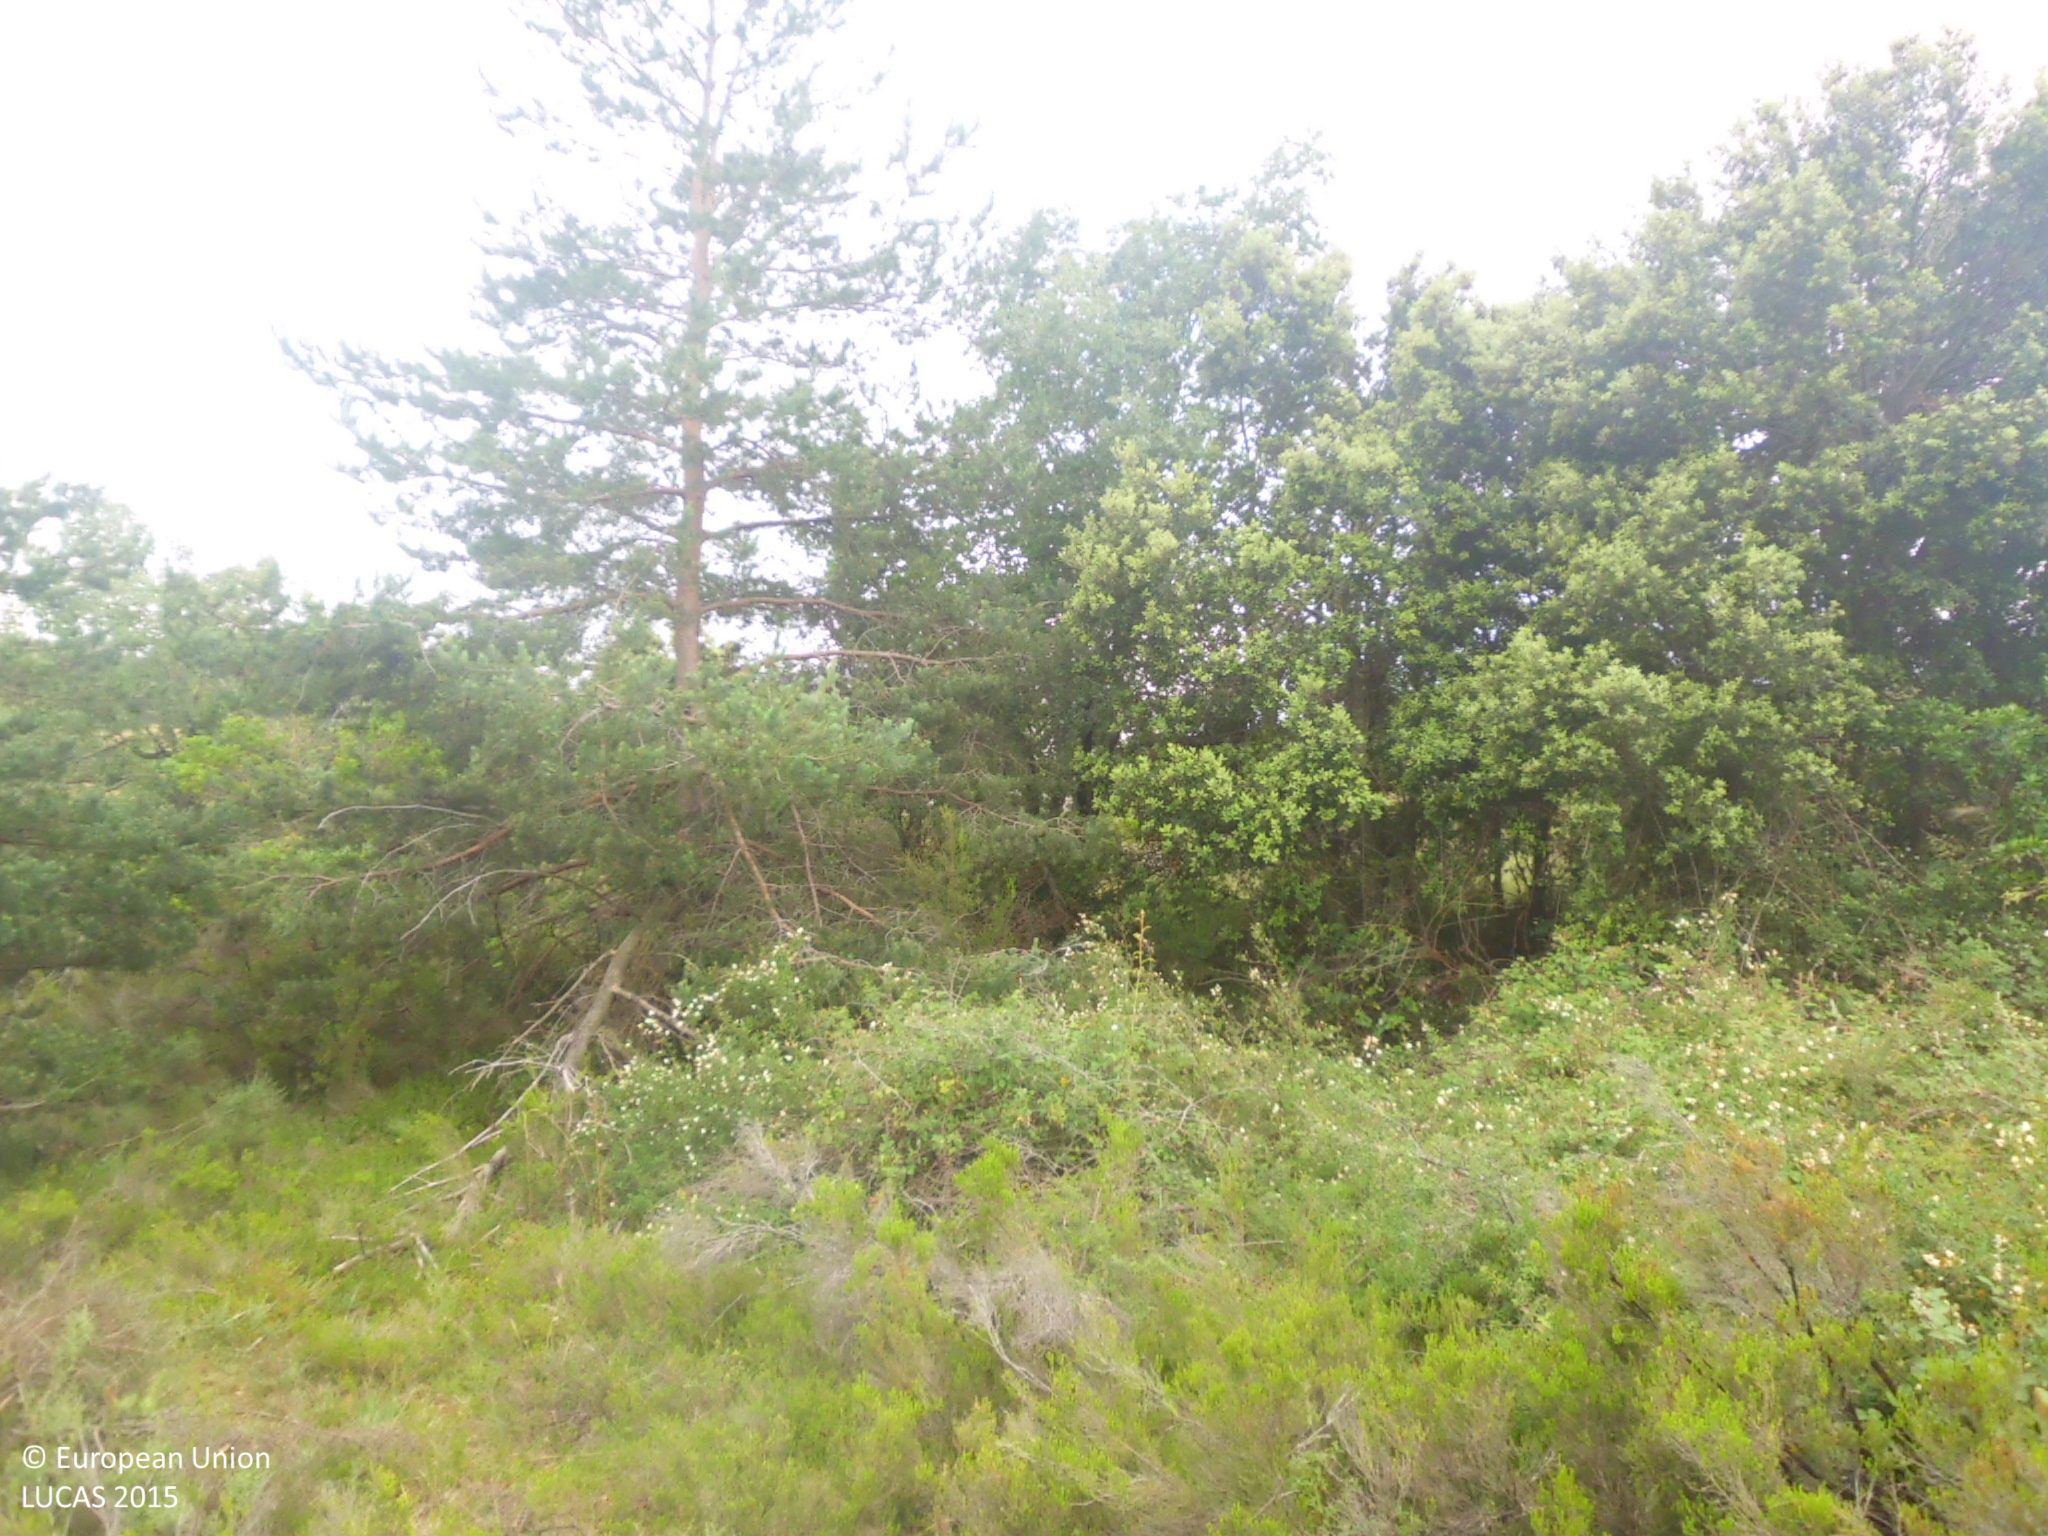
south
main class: Woodland
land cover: Broadleaved woodland
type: acidophilous oak and oak-birch forest
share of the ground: > 75 %
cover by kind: broadleaved forest trees 75 %, shrubs 25 %
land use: Semi-natural and natural areas not in use
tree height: > 5 m
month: June
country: ES
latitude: 42.7293
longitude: -3.1120
